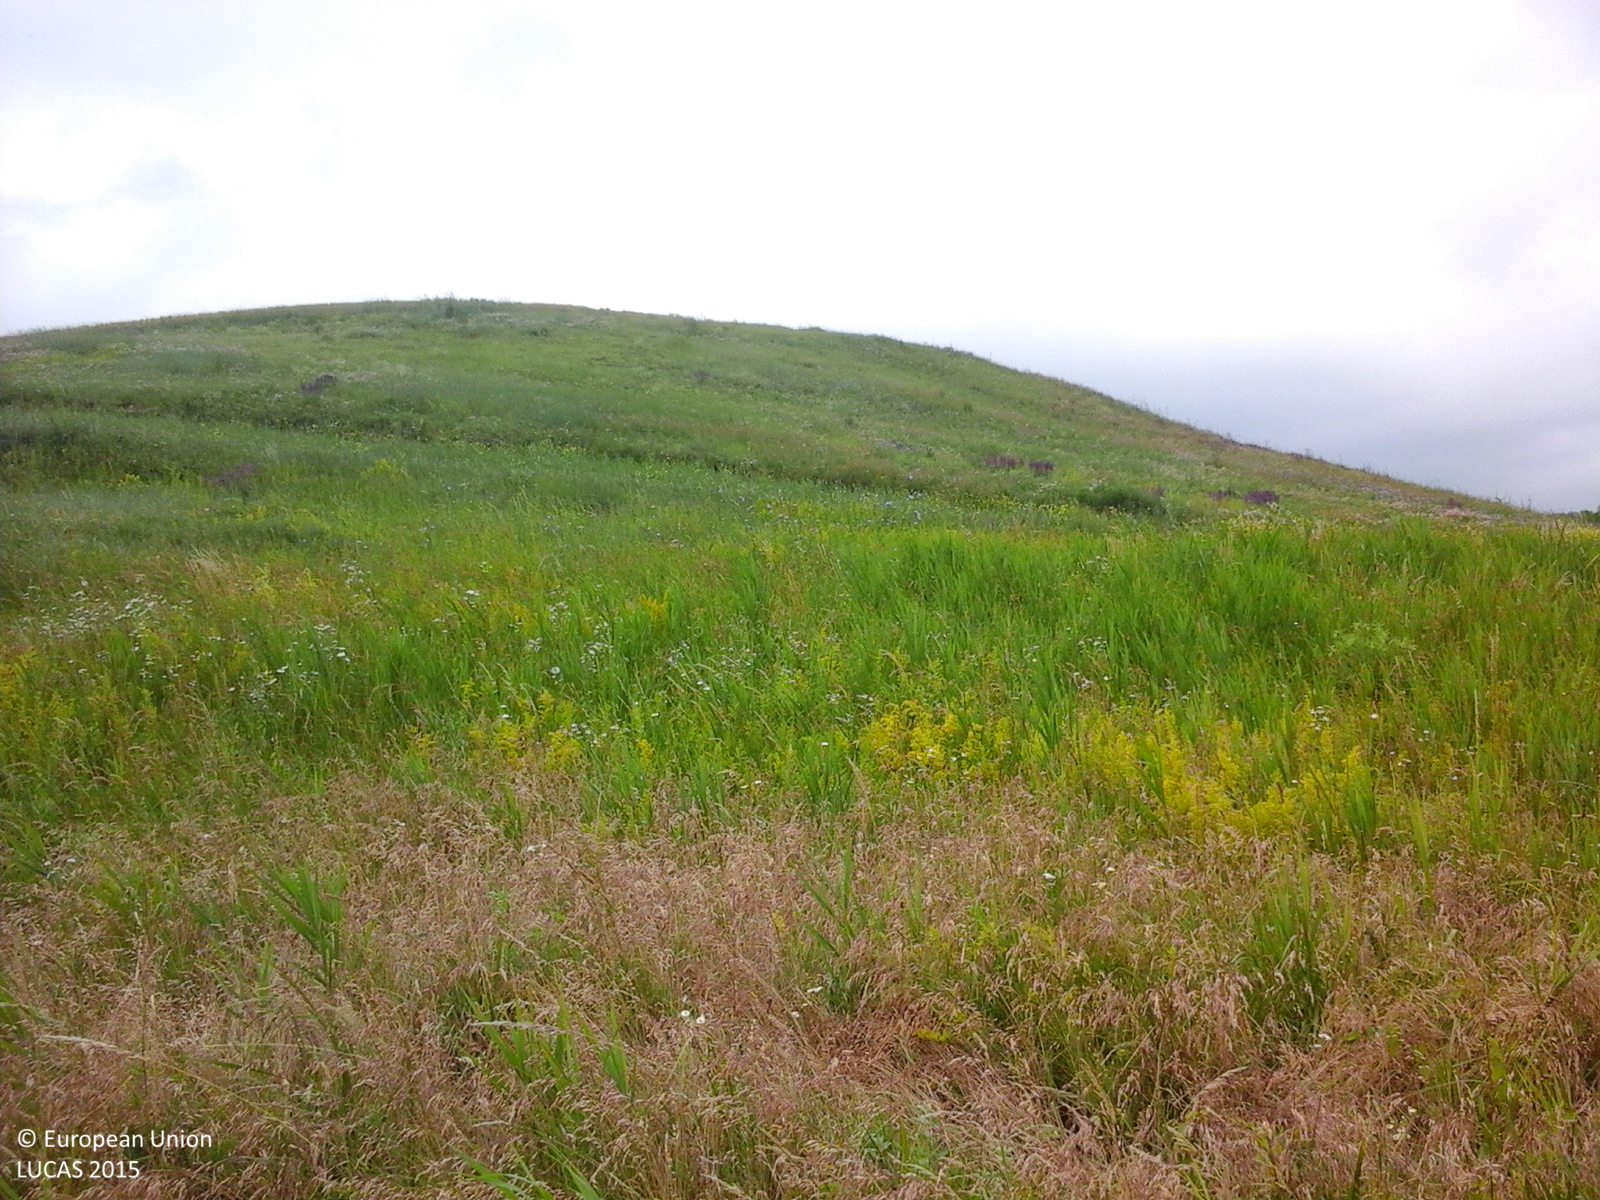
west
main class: Grassland
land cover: Grassland without tree/shrub cover
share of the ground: > 75 %
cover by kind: herbaceous plants 100 %
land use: Agriculture (excluding fallow land and kitchen gardens)
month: June
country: RO
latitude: 48.0506
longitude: 26.3893
